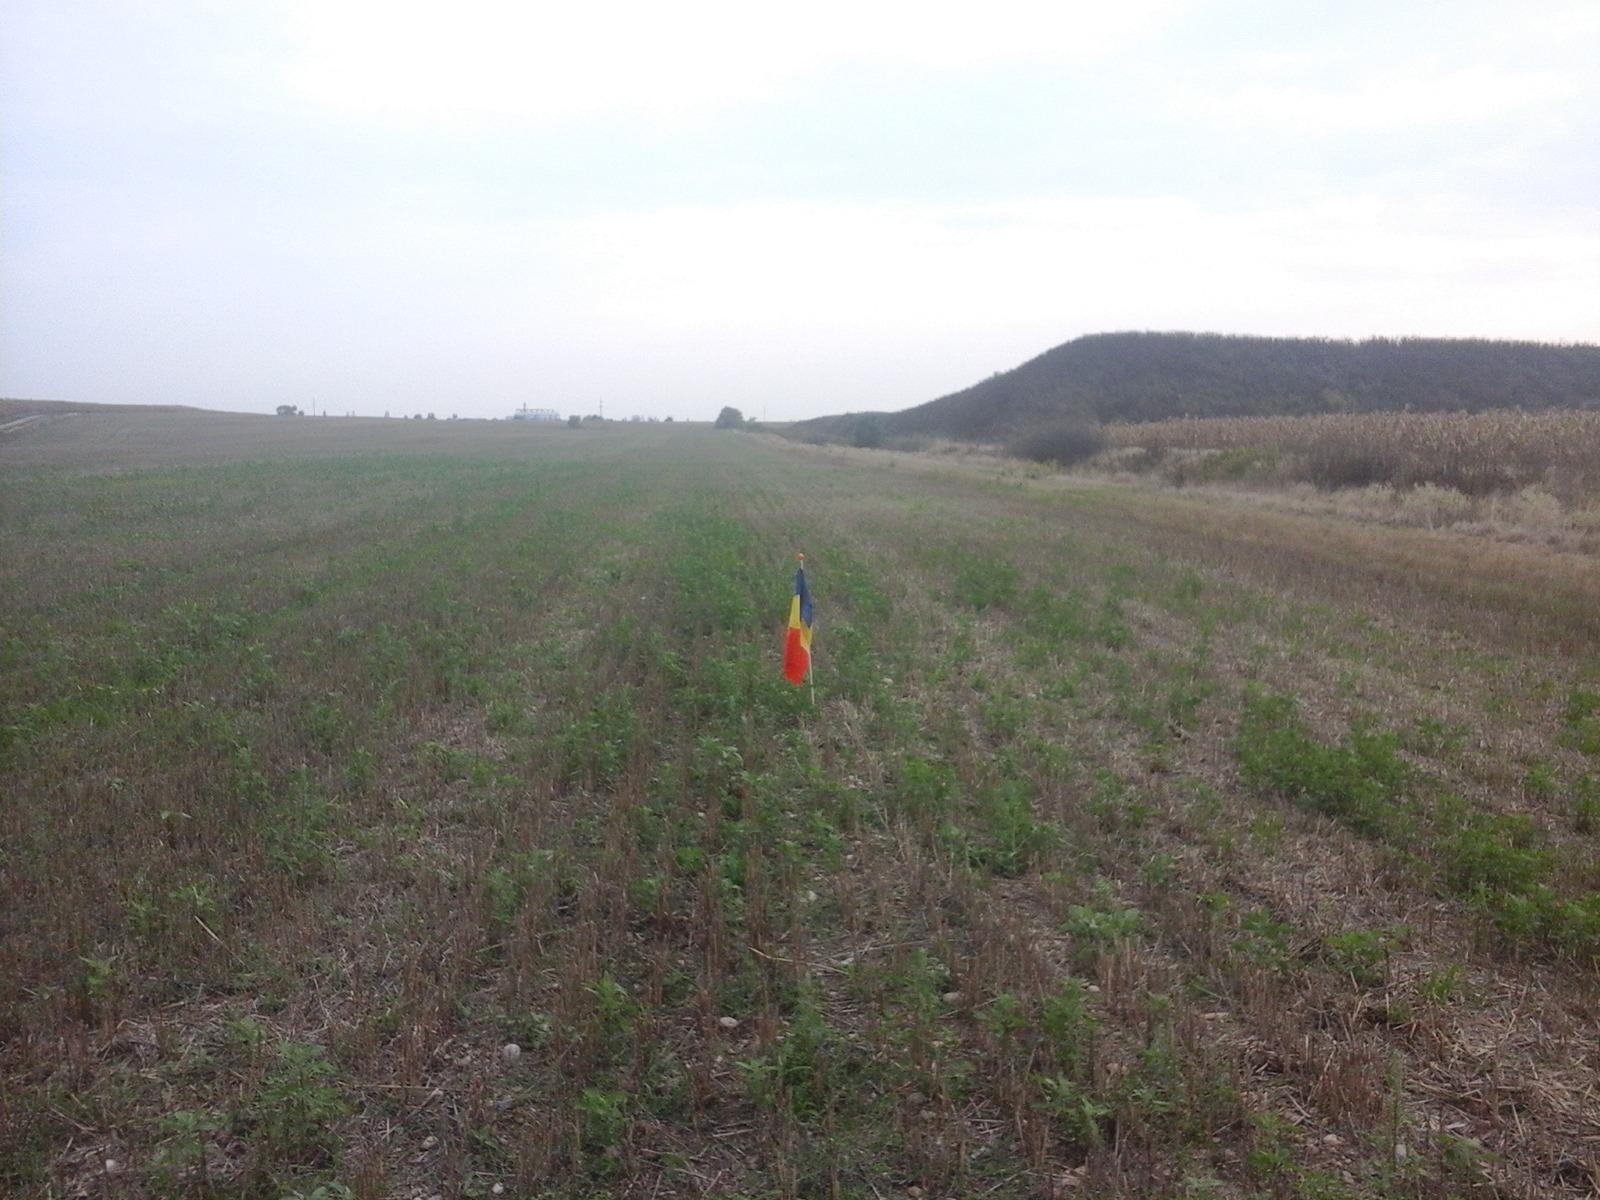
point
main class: Cropland
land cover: Common wheat
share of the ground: < 10 %
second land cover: Spontaneously vegetated surfaces
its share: 50 - 75 %
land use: Agriculture (excluding fallow land and kitchen gardens)
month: August
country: RO
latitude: 46.2365
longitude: 21.5130
